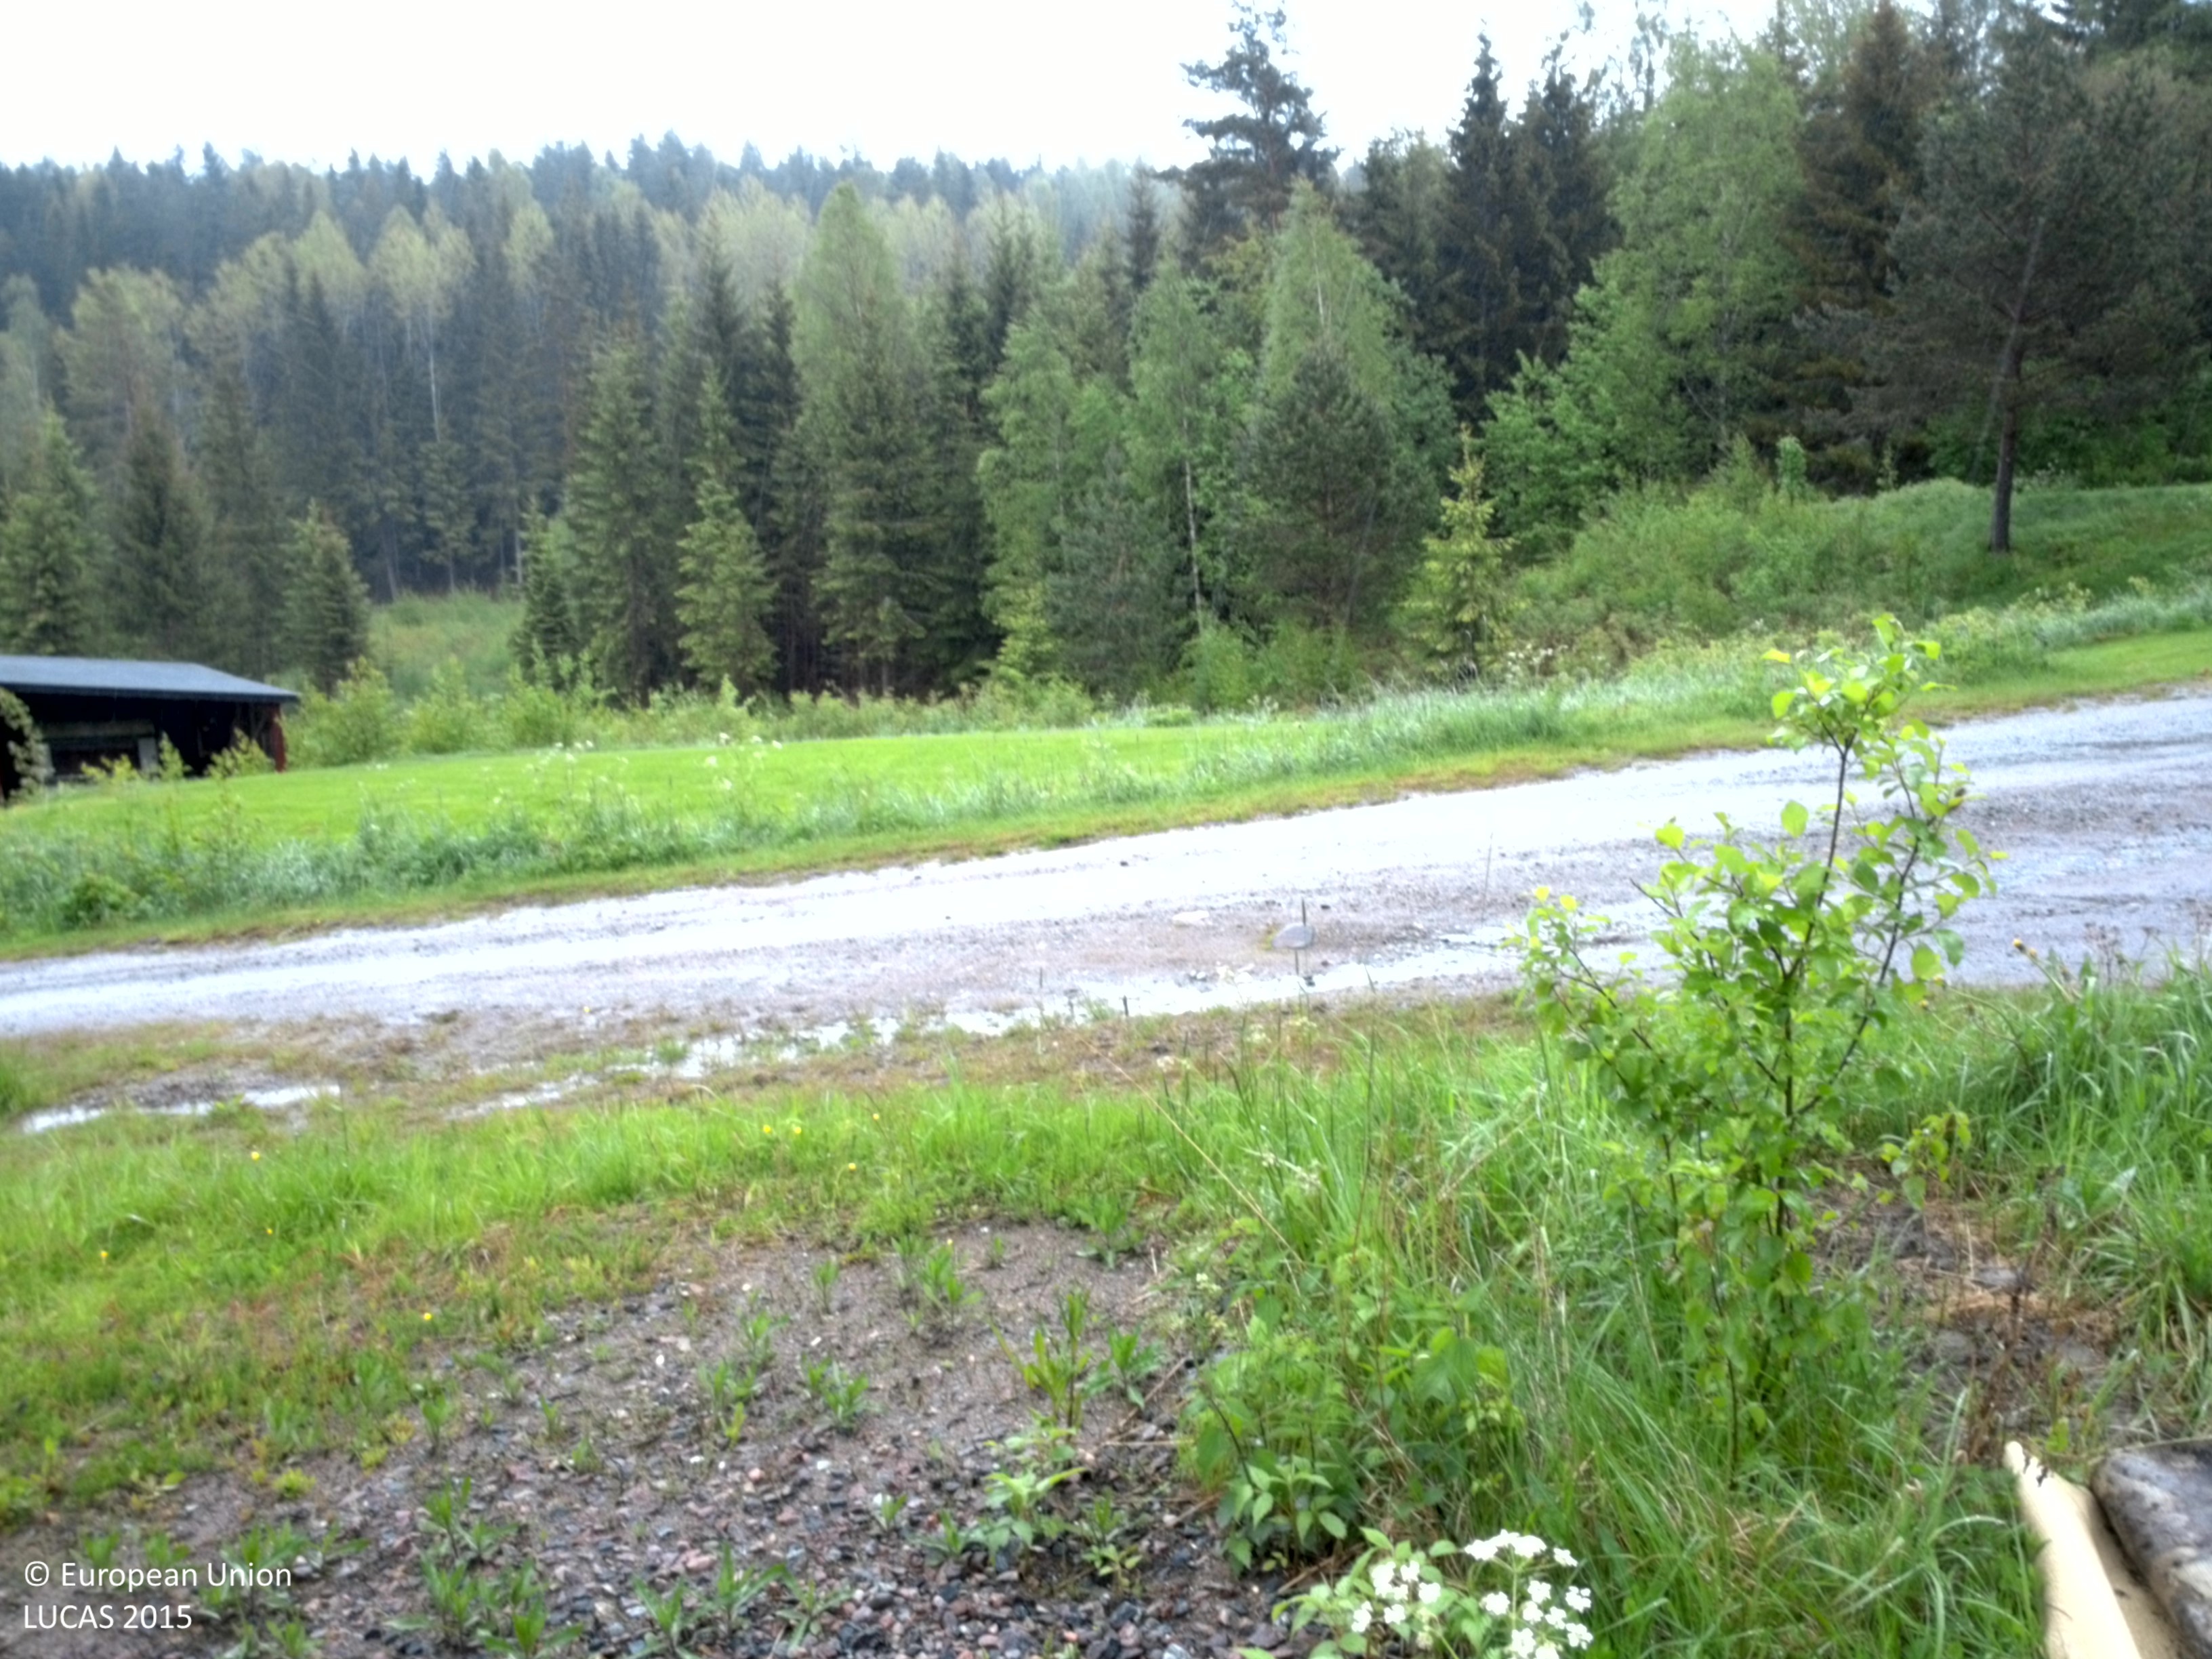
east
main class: Grassland
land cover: Spontaneously vegetated surfaces
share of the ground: > 75 %
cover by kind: herbaceous plants 90 %, shrubs 5 %
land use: Residential
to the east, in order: Spontaneously vegetated surfaces; Paved roads, cycling and walking lanes; Grass margins; Ditches and canals; Grassland without tree/shrub cover; Shrubland without tree cover; Spruce dominated coniferous woodland; Shrubland without tree cover; Paved roads, cycling and walking lanes; Ditches and canals; Spruce dominated mixed woodland
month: June
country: SE
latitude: 59.6915
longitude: 12.4273
